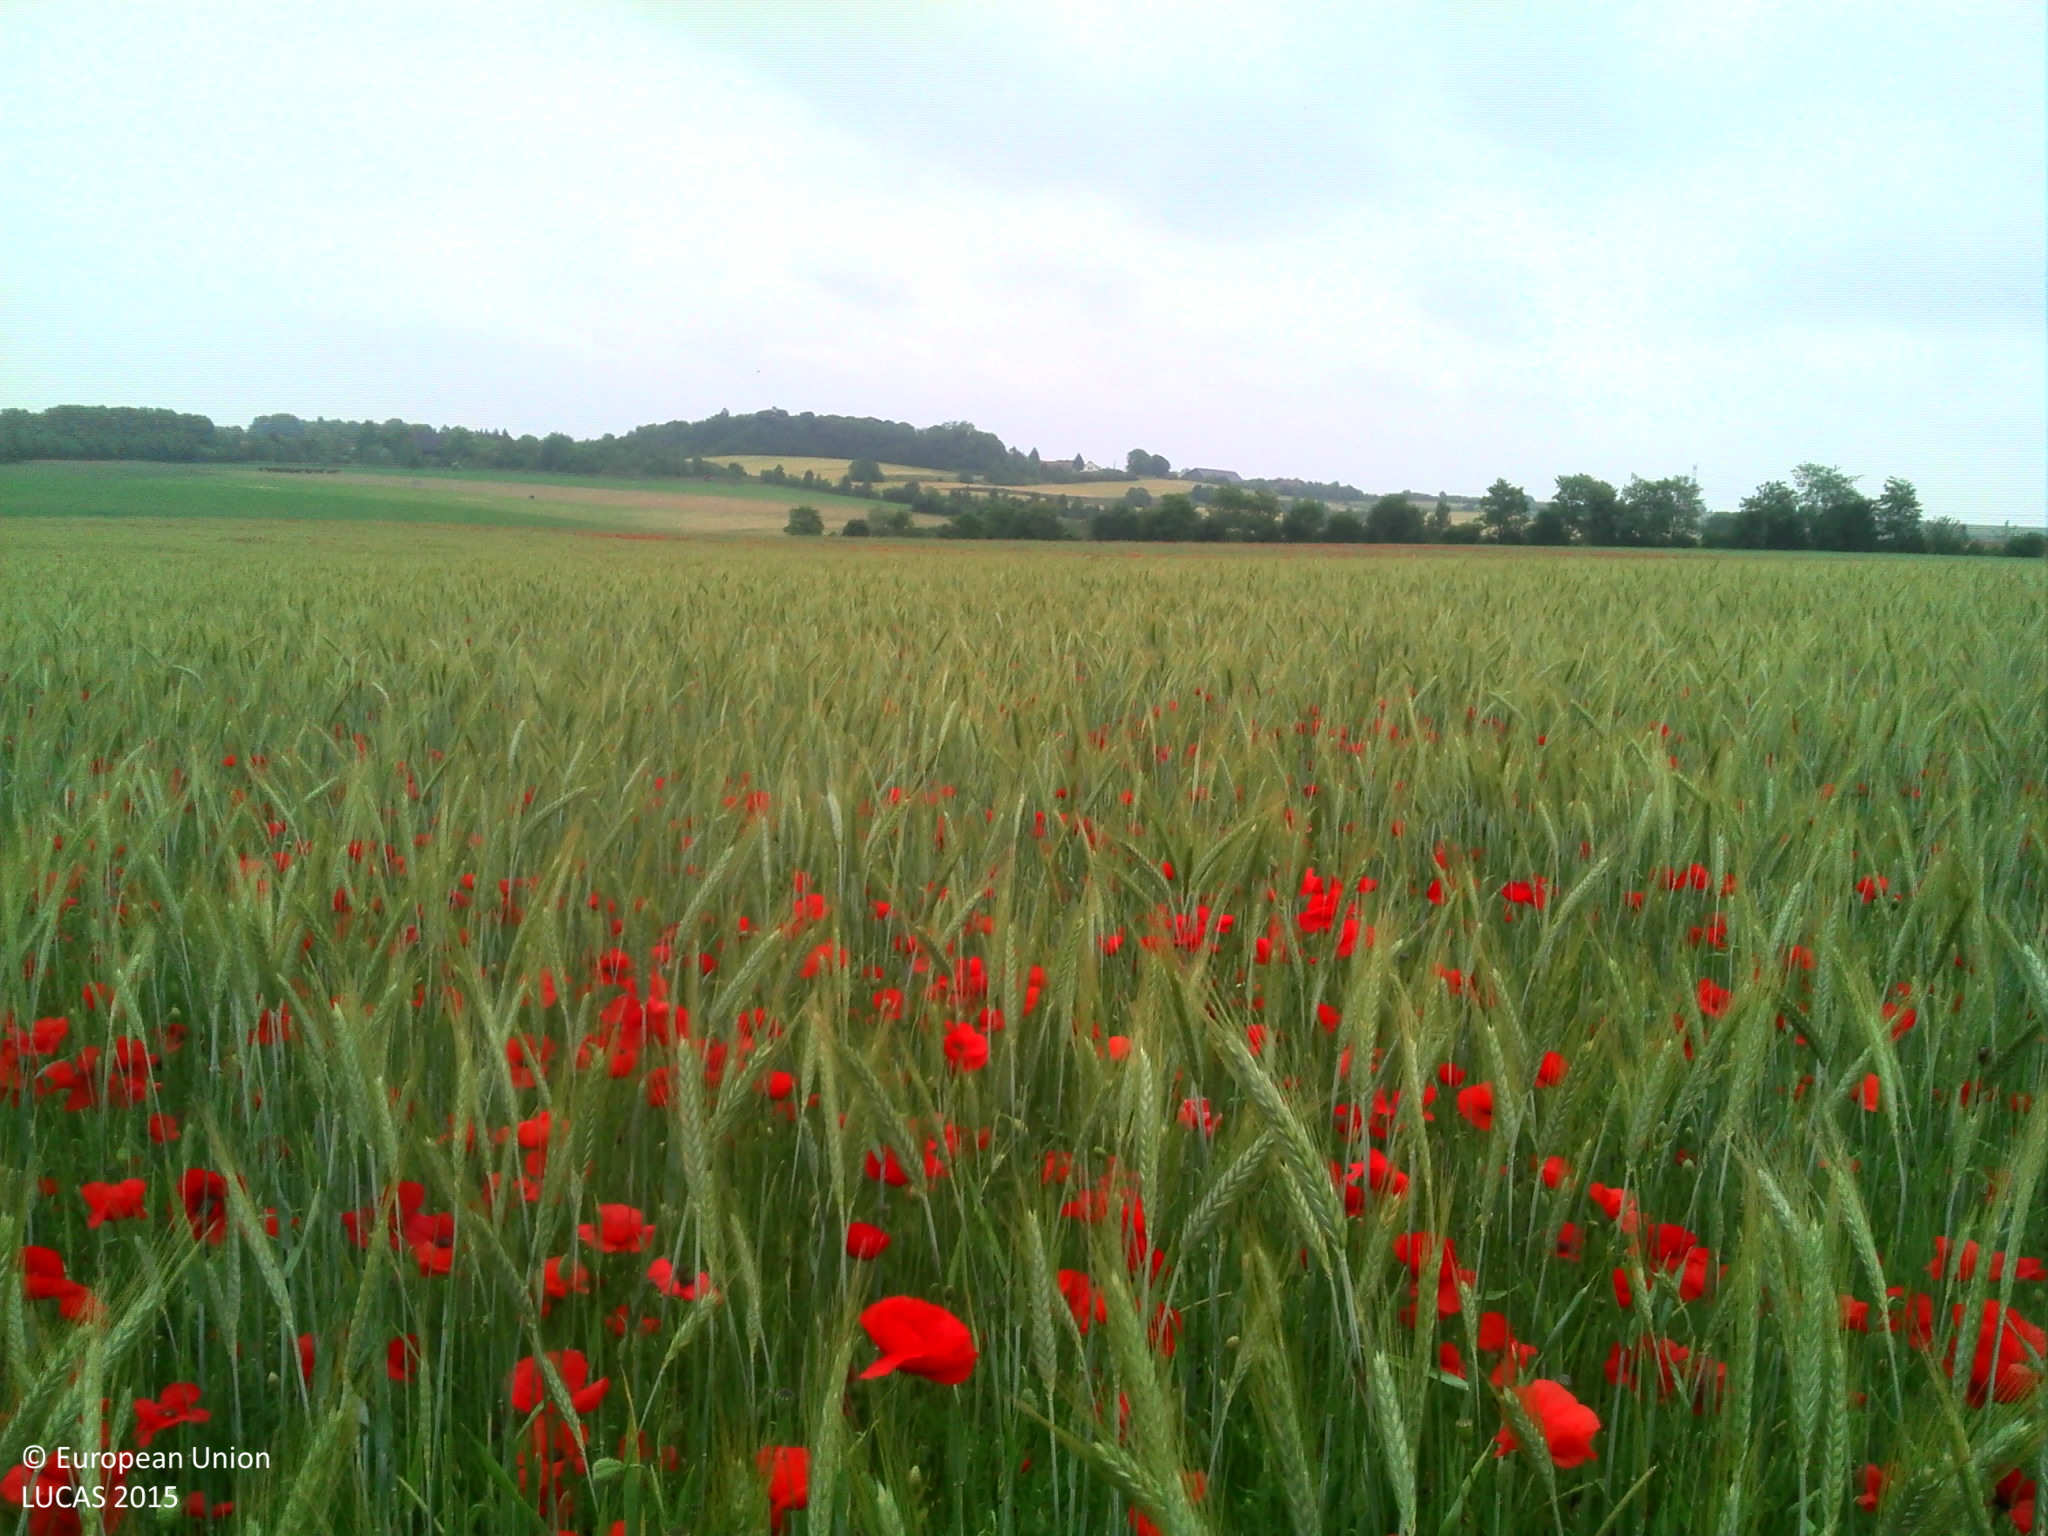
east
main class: Cropland
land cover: Barley
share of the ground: > 75 %
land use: Agriculture (excluding fallow land and kitchen gardens)
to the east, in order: Barley; Oats
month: June
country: FR
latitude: 49.7363
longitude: 2.2021
